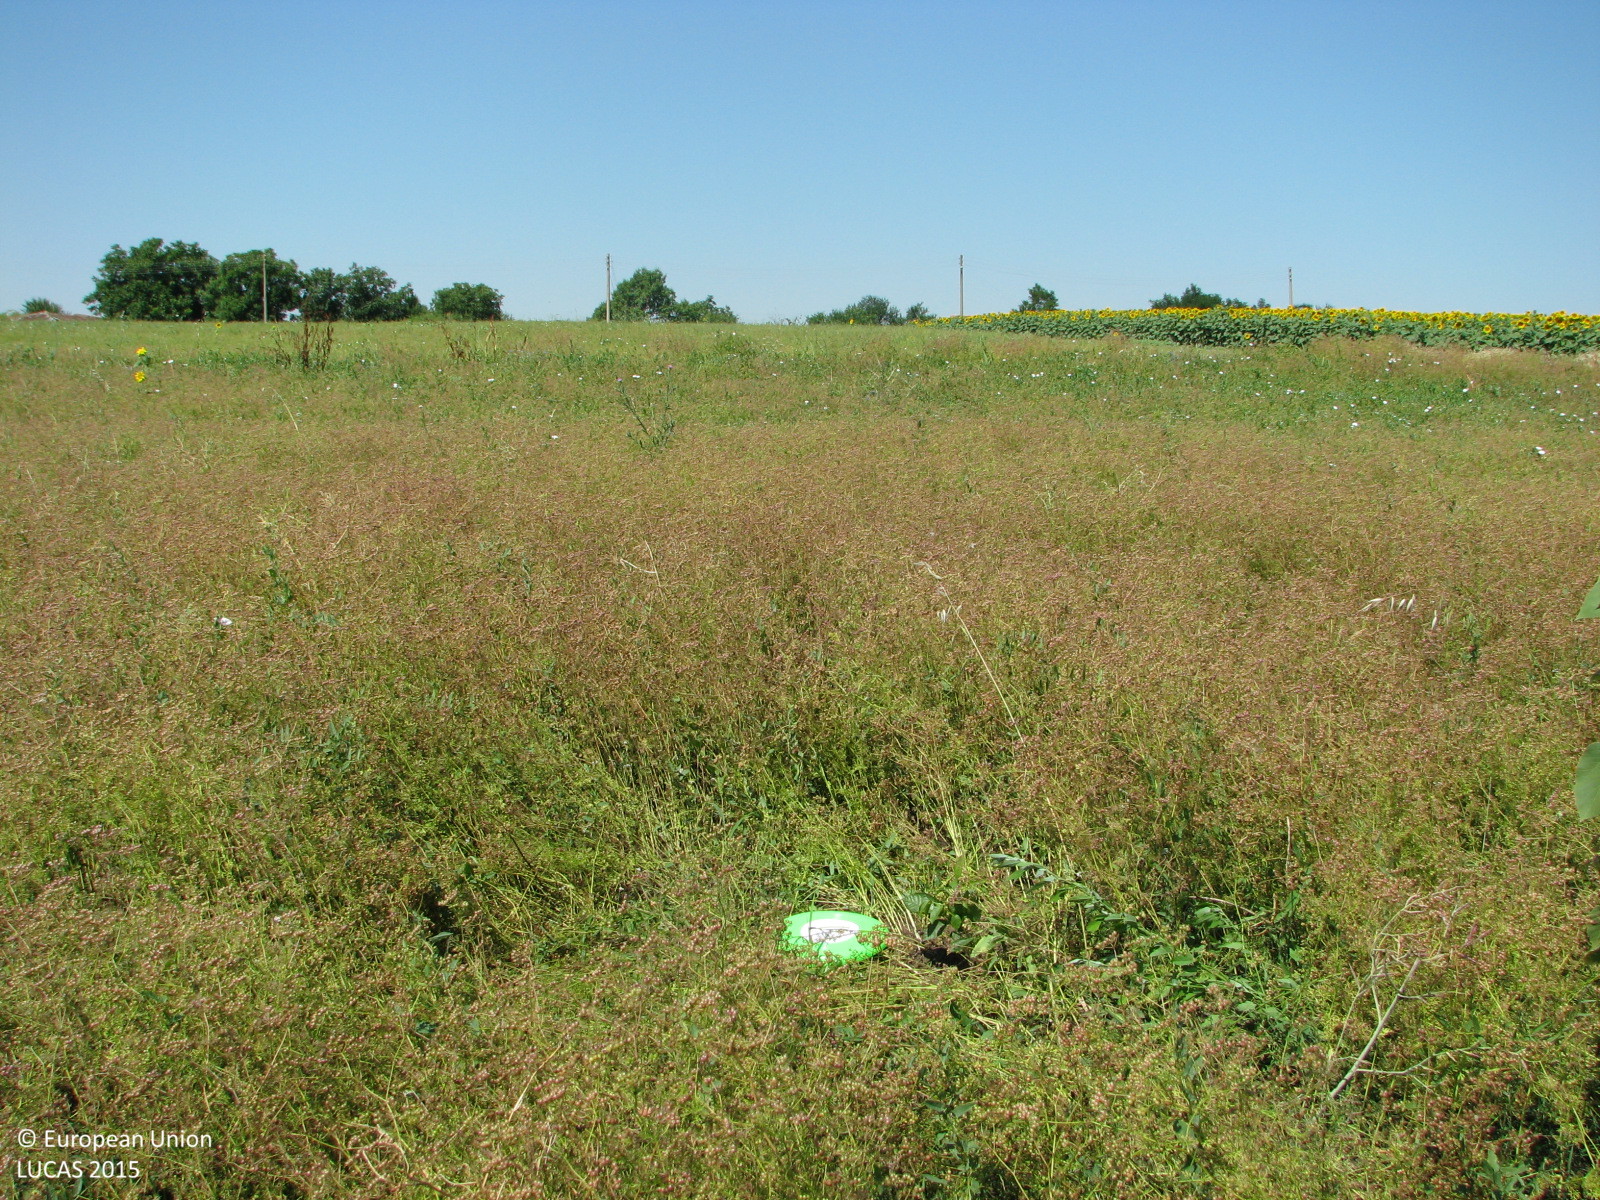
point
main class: Cropland
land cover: Other non-permanent industrial crops
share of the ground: > 75 %
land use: Agriculture (excluding fallow land and kitchen gardens)
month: July
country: BG
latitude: 42.4829
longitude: 26.4034
